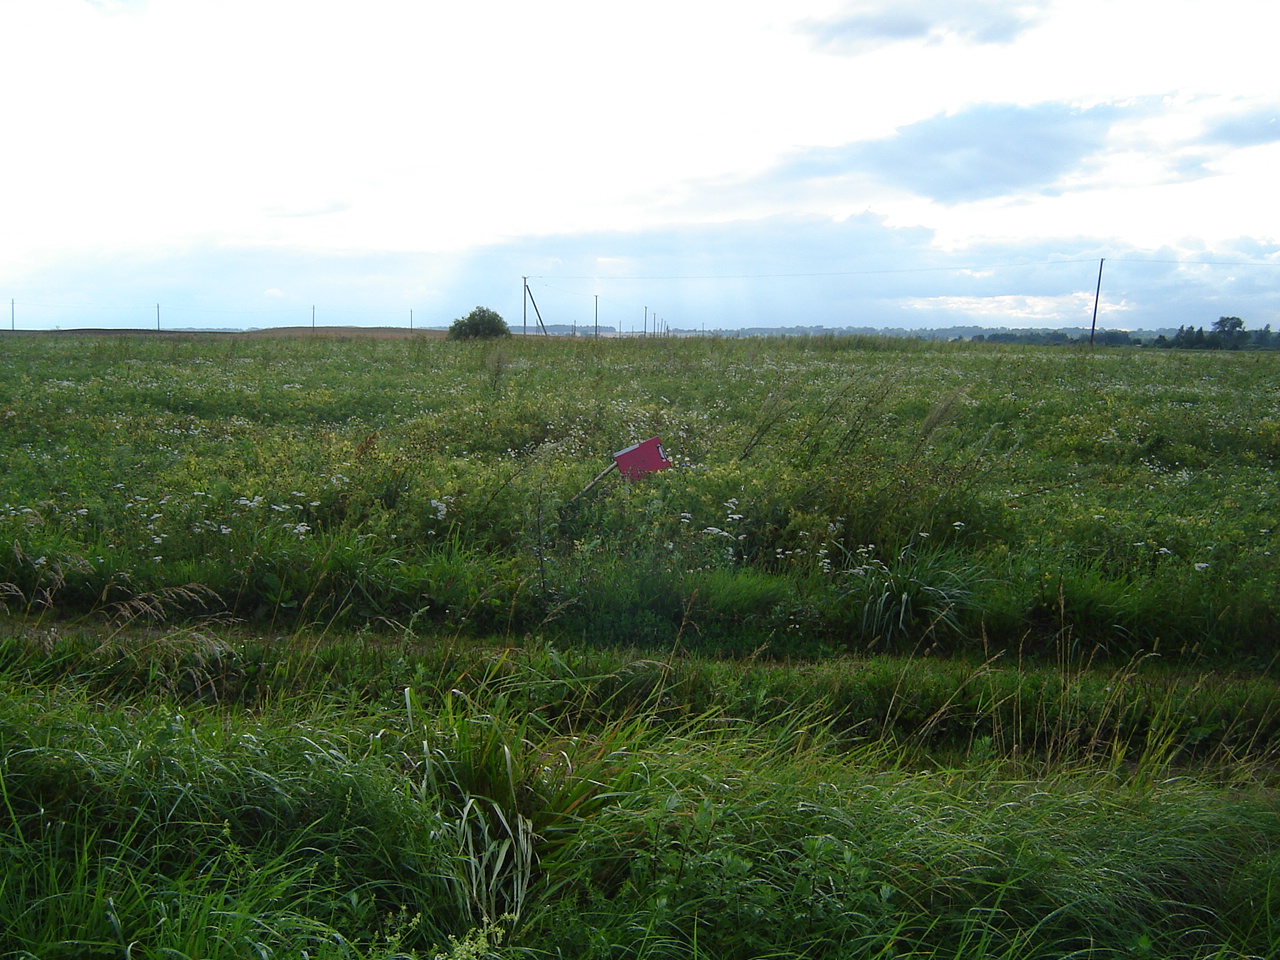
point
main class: Cropland
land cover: Dry pulses
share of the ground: > 75 %
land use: Agriculture (excluding fallow land and kitchen gardens)
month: July
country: LT
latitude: 55.2428
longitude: 25.0075
